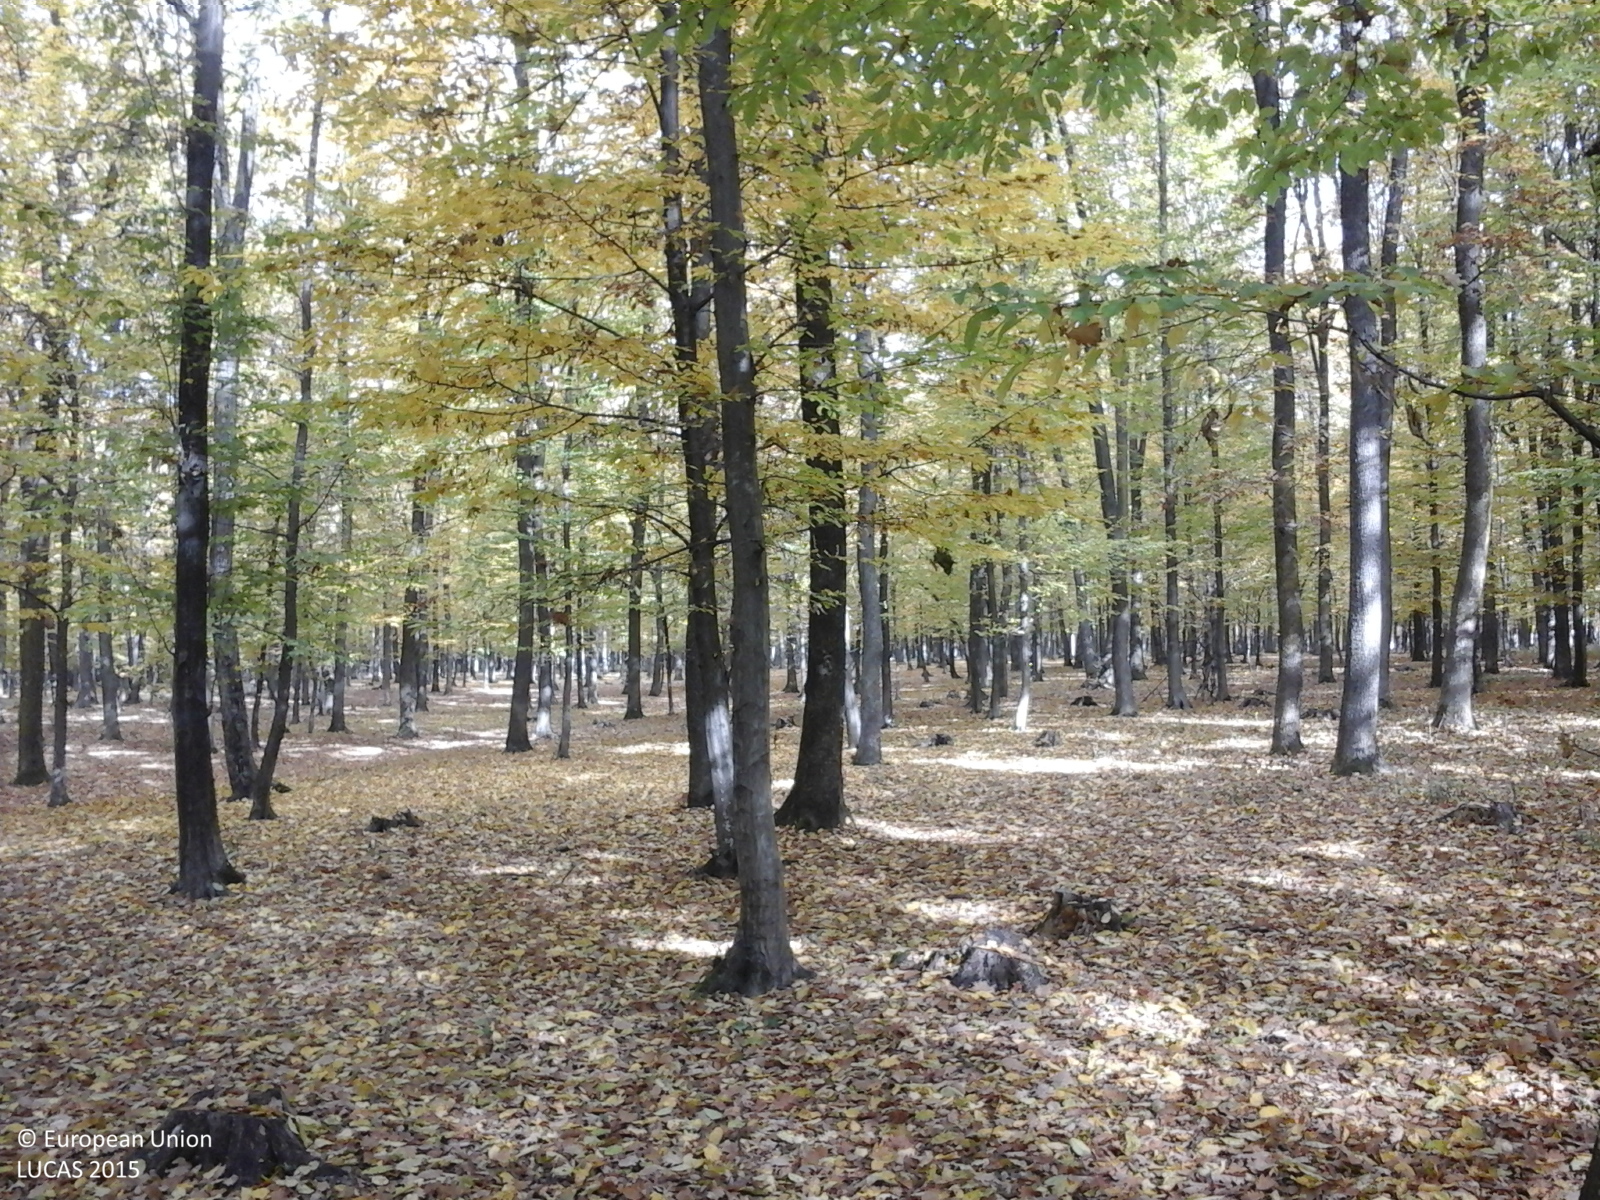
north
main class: Woodland
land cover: Broadleaved woodland
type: beech forest
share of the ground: > 75 %
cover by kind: broadleaved forest trees 100 %
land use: Forestry
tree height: > 5 m
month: October
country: RO
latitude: 46.0090
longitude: 27.1035
